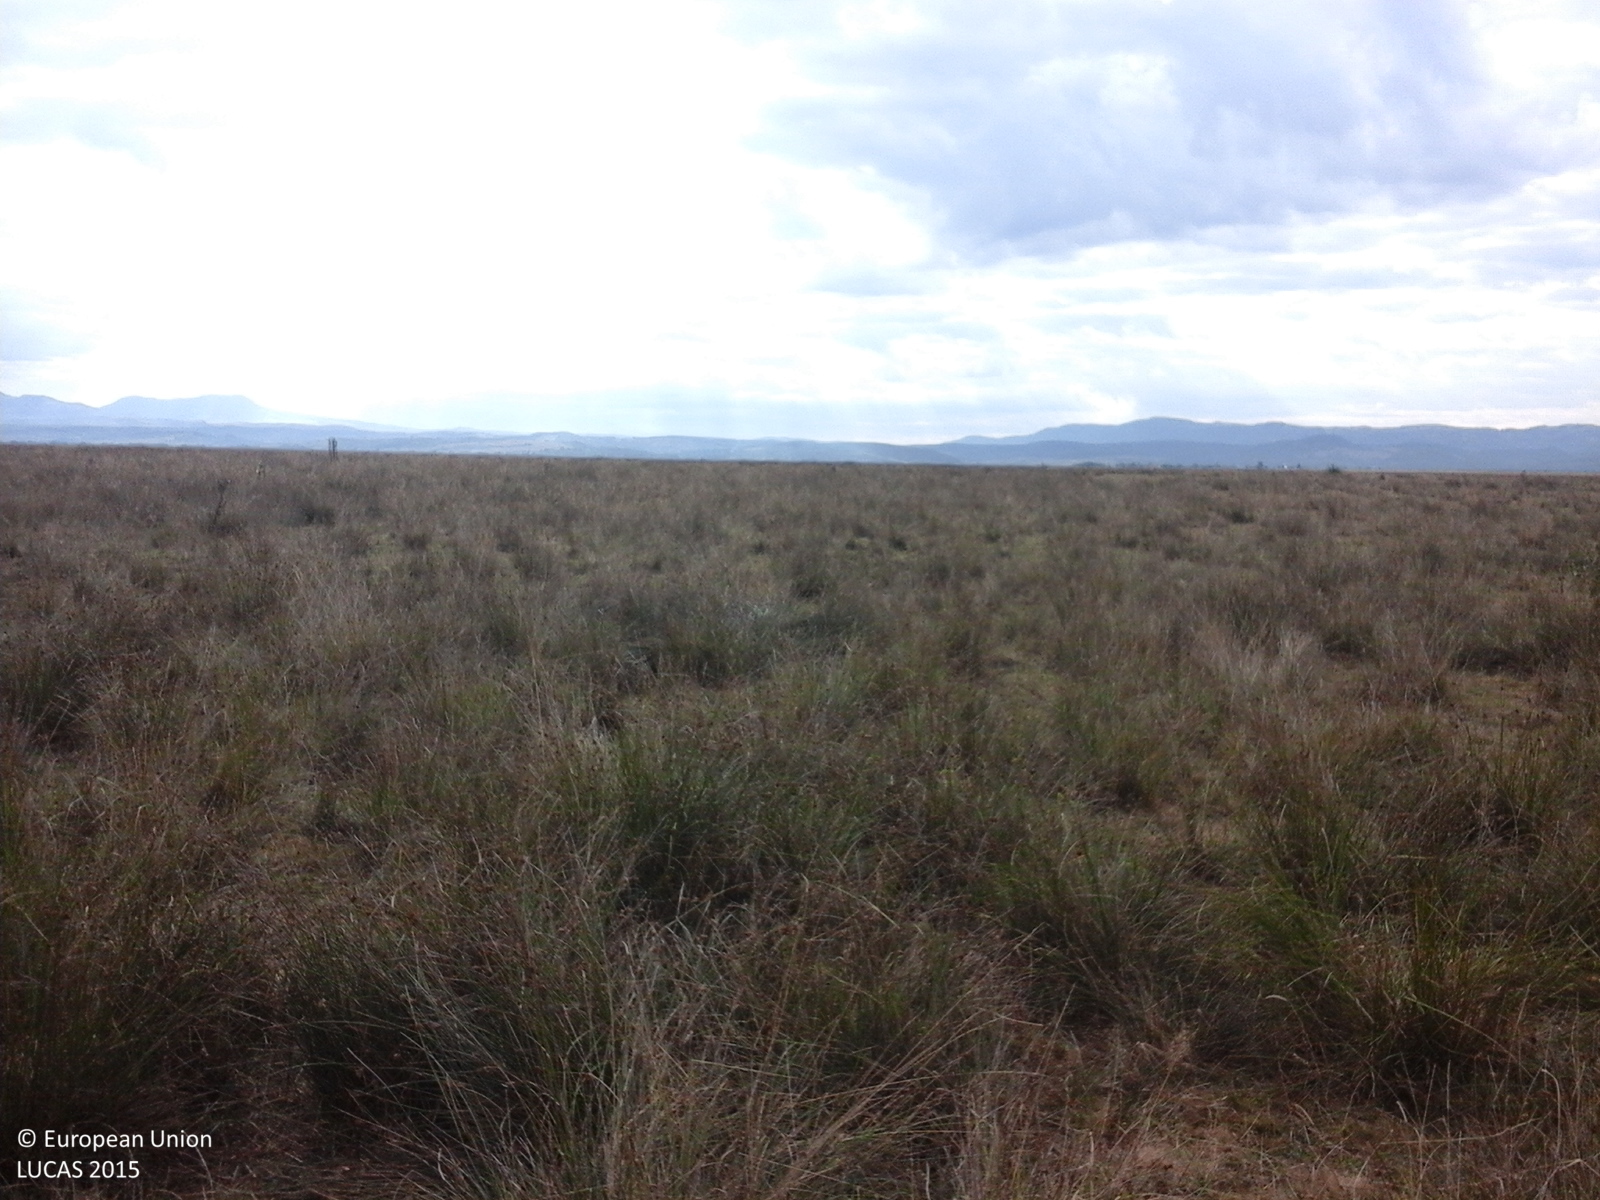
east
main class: Grassland
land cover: Grassland without tree/shrub cover
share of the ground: > 75 %
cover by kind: herbaceous plants 100 %
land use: Agriculture (excluding fallow land and kitchen gardens)
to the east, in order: Grassland without tree/shrub cover
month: September
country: RO
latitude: 47.5868
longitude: 23.5180
